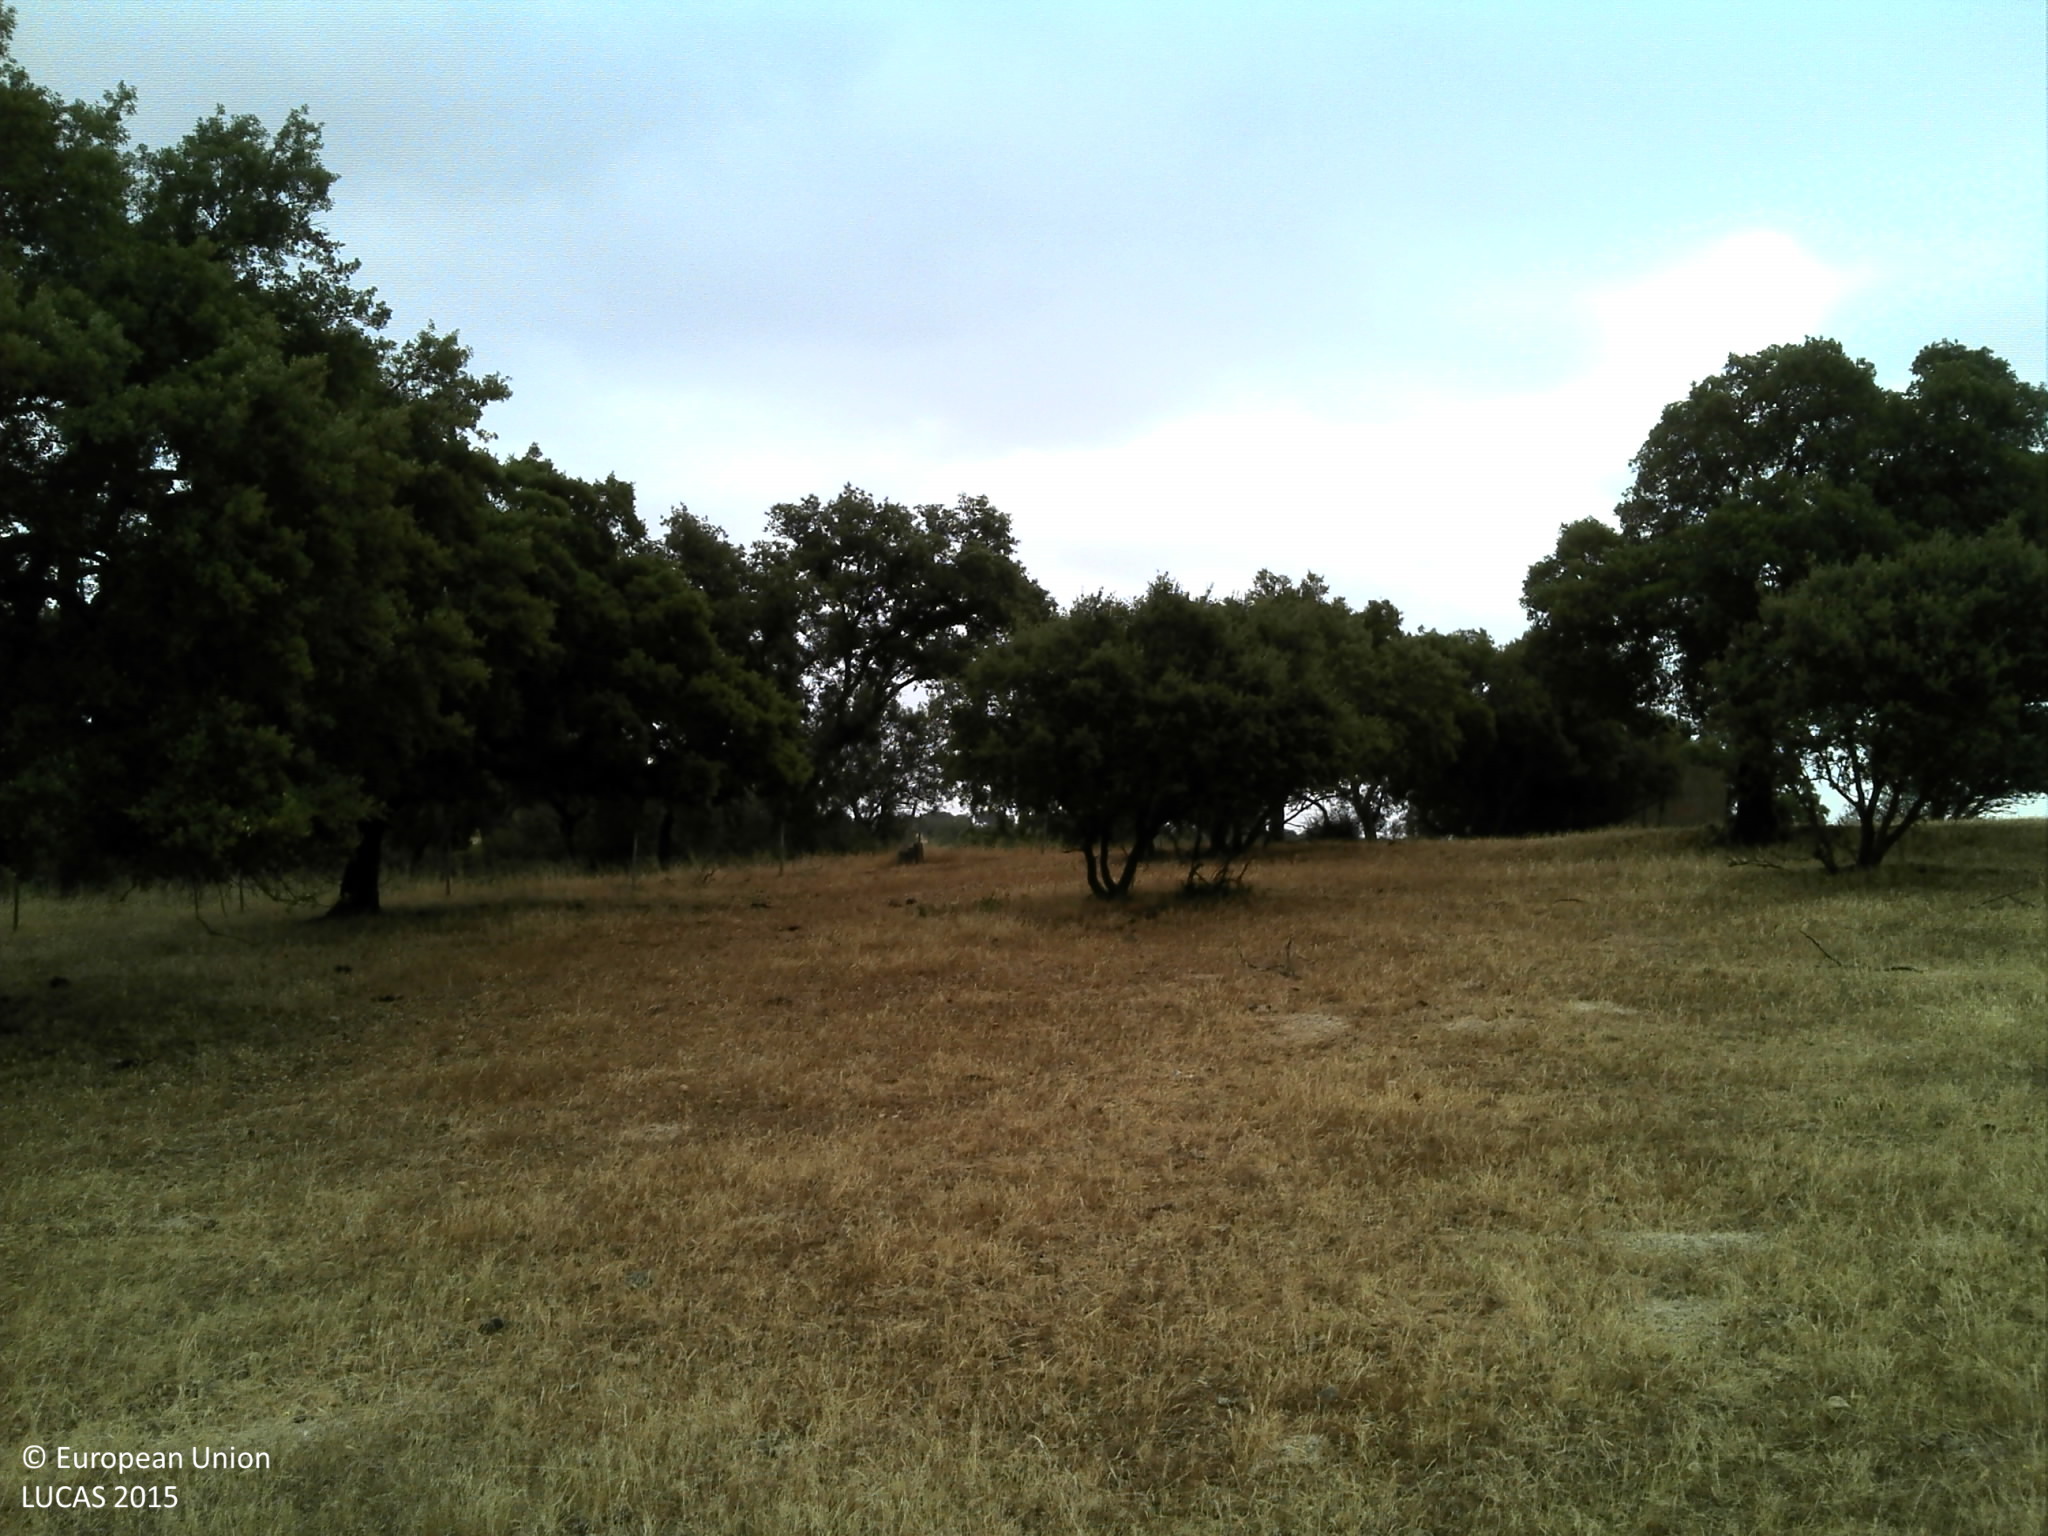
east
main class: Grassland
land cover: Spontaneously vegetated surfaces
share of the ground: 10 - 25 %
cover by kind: unconsolidated bare surface 75 %, herbaceous plants 25 %
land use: Agriculture (excluding fallow land and kitchen gardens)
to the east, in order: Spontaneously vegetated surfaces; Broadleaved woodland; Grassland with sparse tree/shrub cover; Fences; Olive groves; Broadleaved woodland; Grassland without tree/shrub cover; Olive groves; Ditches and canals; Artificial constructions in urban areas; Grass margins; Tracks; Grass margins; Fences; Other fresh vegetables; Fences; Grassland without tree/shrub cover; Electric lines
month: June
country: PT
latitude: 38.3351
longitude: -7.9633
